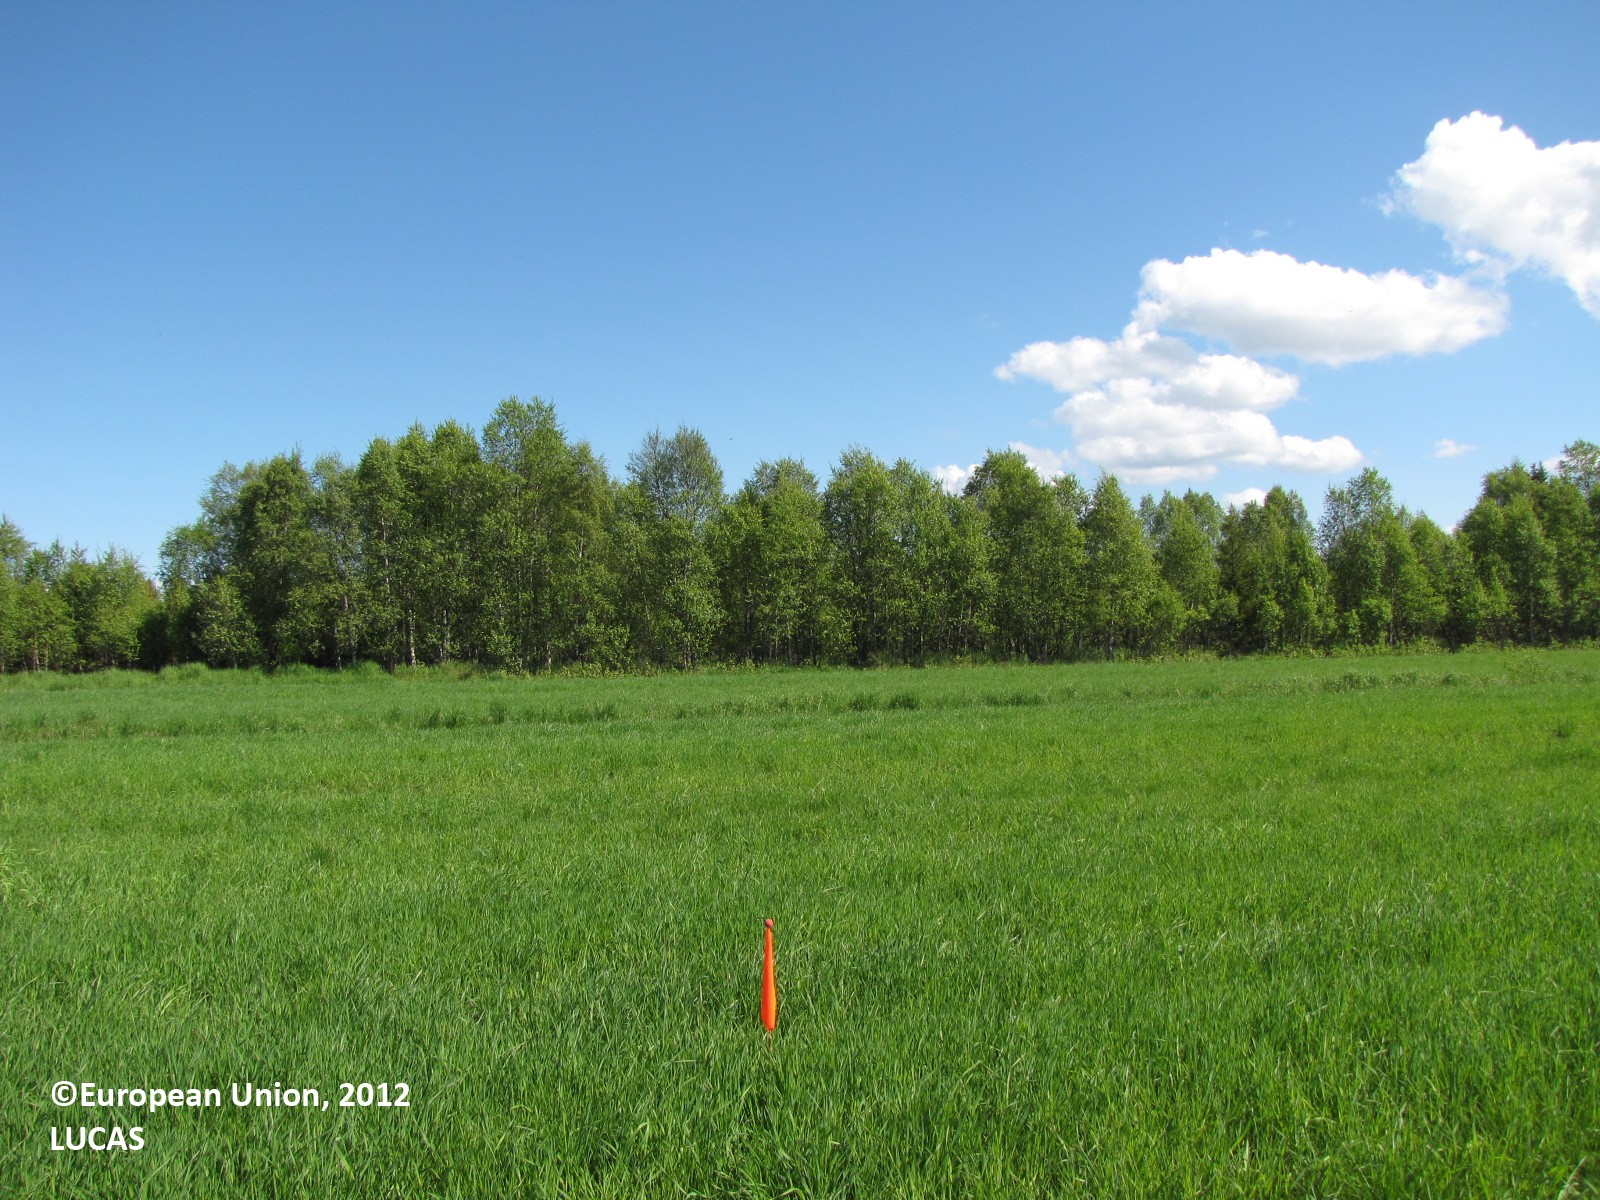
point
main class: Grassland
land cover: Grassland without tree/shrub cover
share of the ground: > 75 %
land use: Agriculture (excluding fallow land and kitchen gardens)
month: June
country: FI
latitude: 66.0108
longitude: 24.7582
